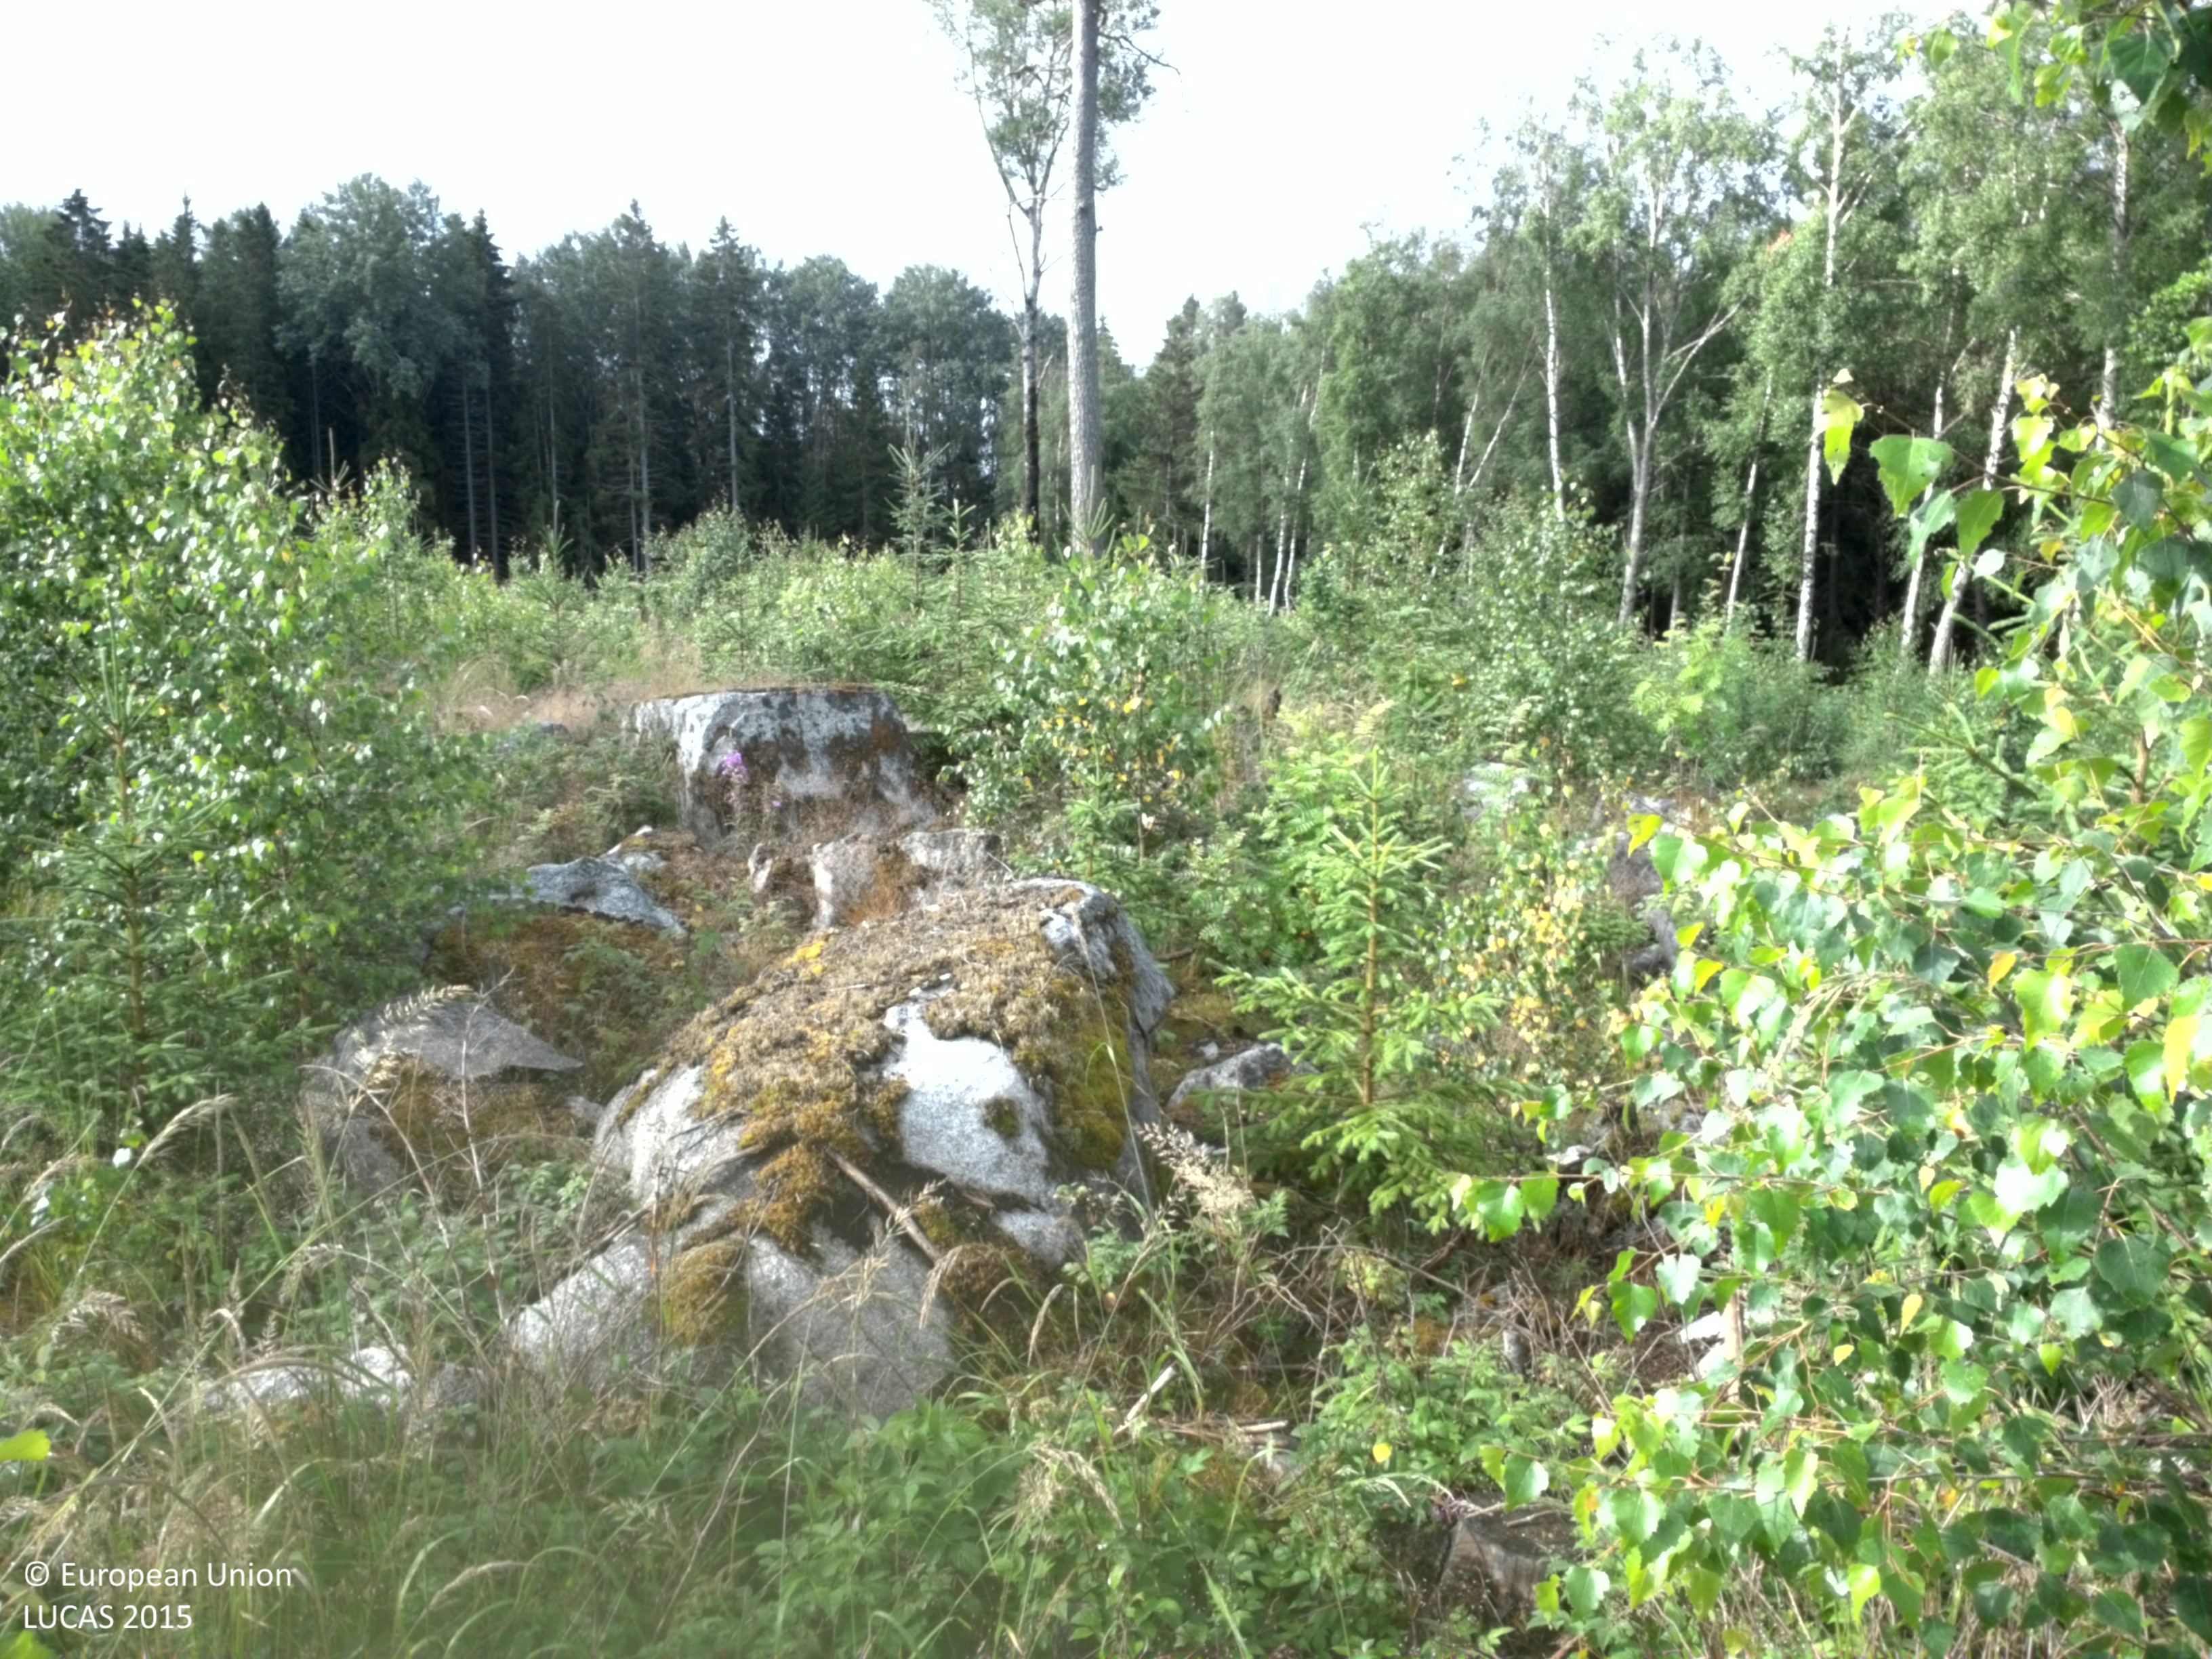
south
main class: Woodland
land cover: Broadleaved woodland
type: boreal forest
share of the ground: 25 - 50 %
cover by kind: herbaceous plants 50 %, broadleaved forest trees 40 %, coniferous forest trees 10 %
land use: Forestry
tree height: < 5 m
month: July
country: SE
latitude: 60.0656
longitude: 17.2683
